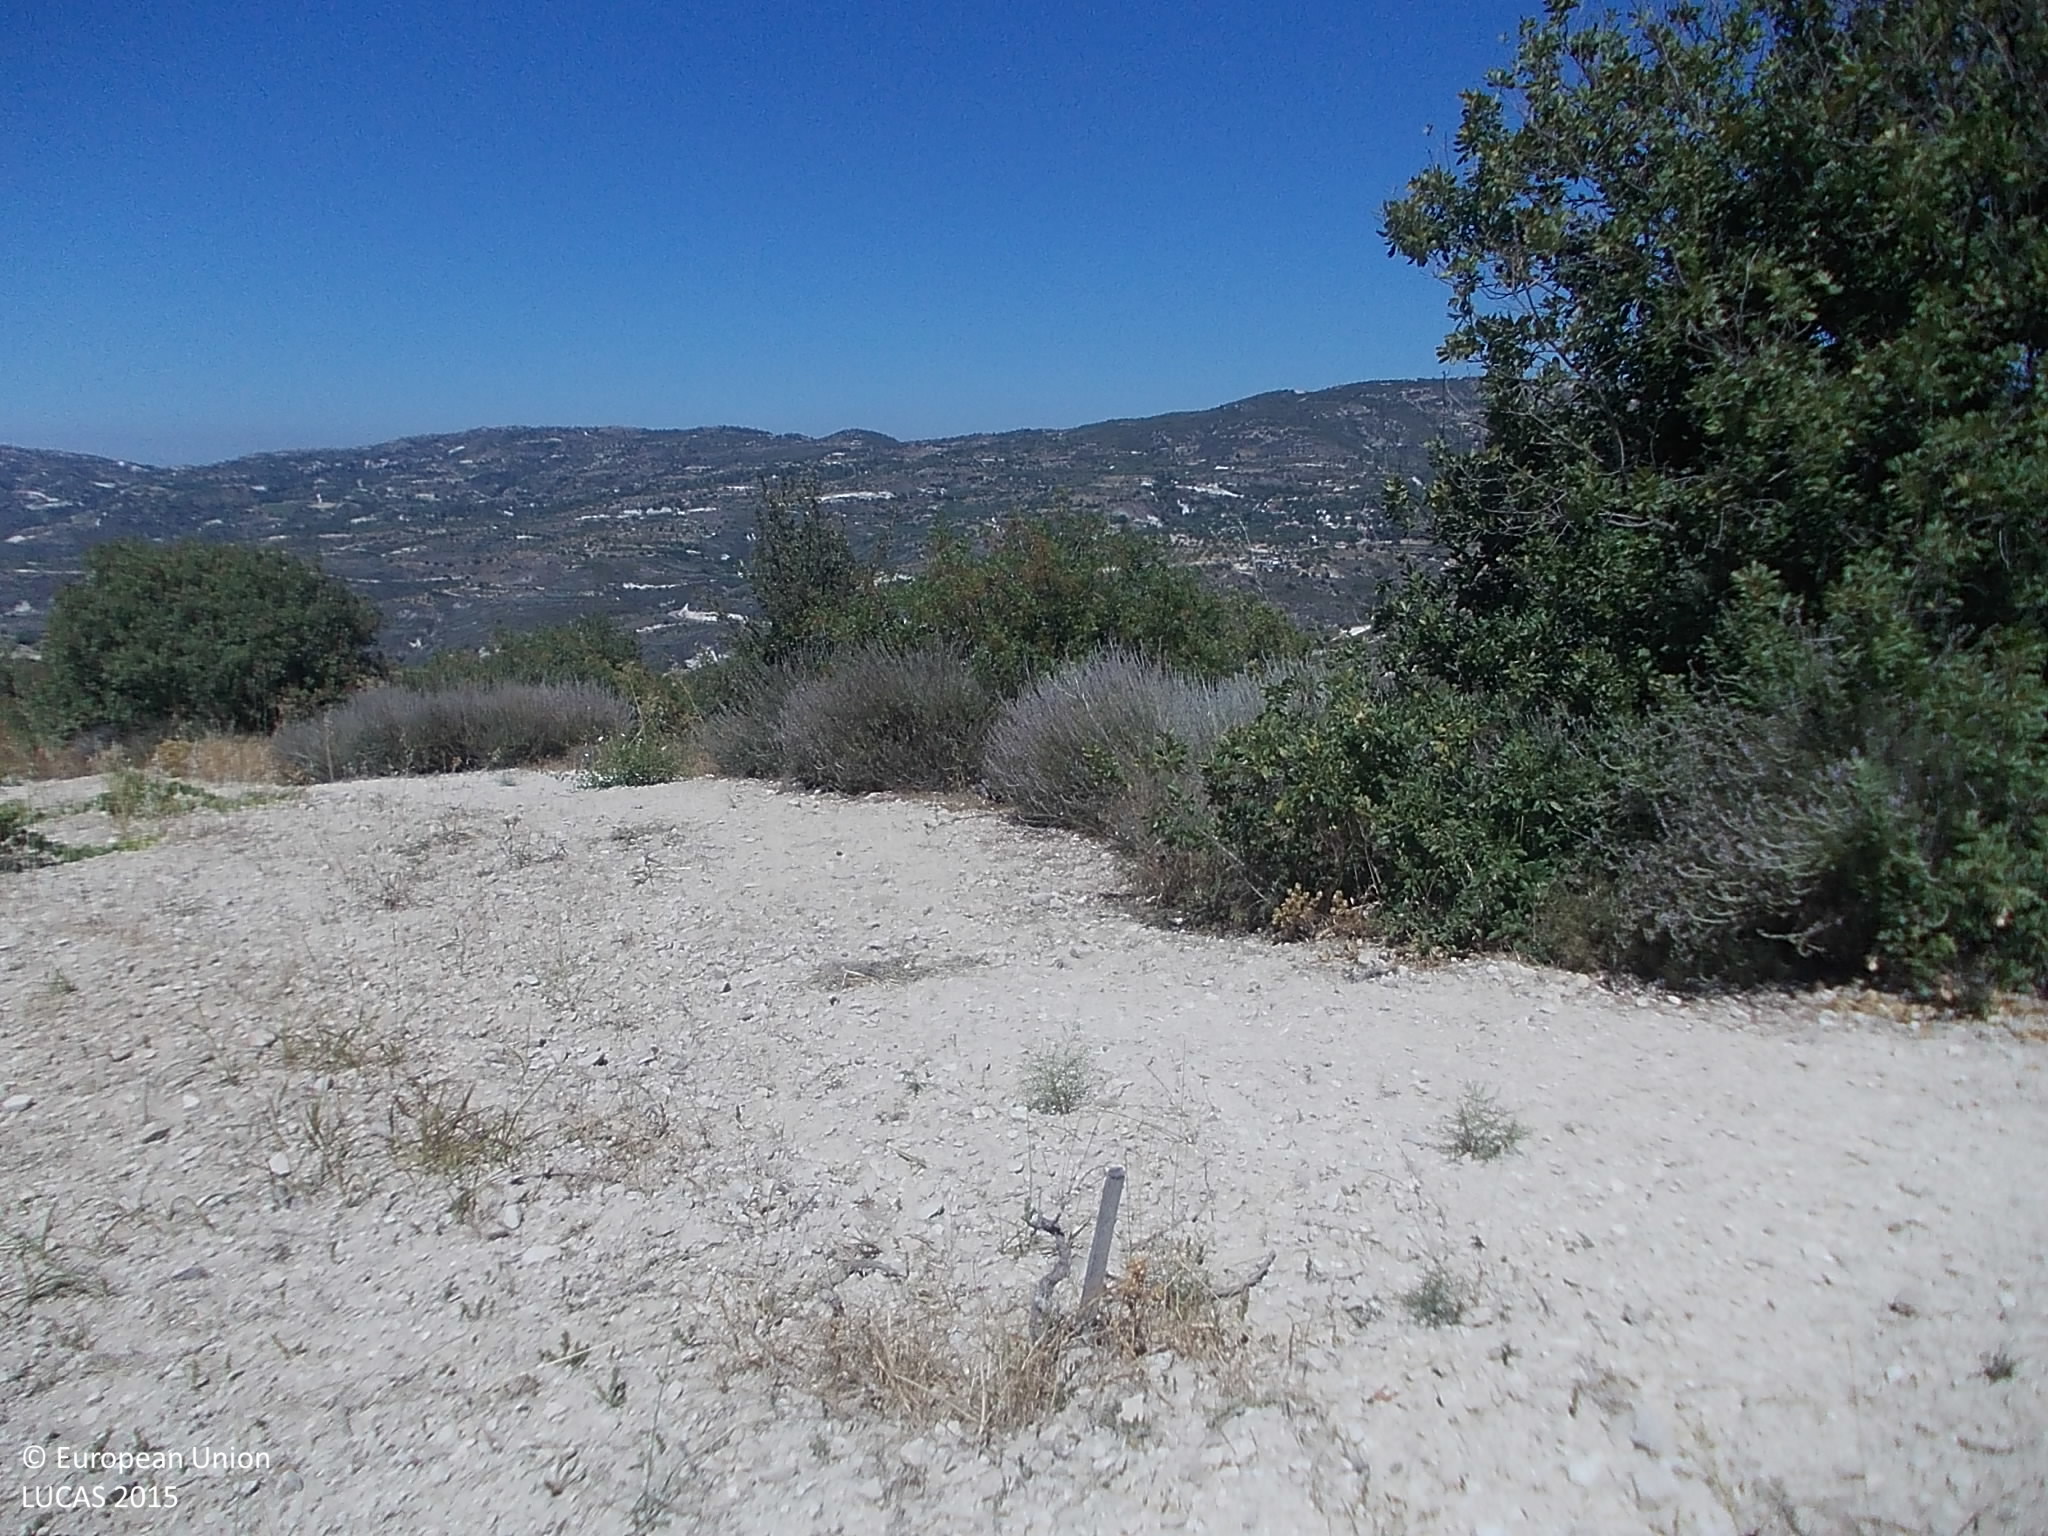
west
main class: Cropland
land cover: Vineyards
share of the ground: 25 - 50 %
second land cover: Other bare soil
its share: > 75 %
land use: Agriculture (excluding fallow land and kitchen gardens)
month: July
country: CY
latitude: 34.8585
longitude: 32.7463
